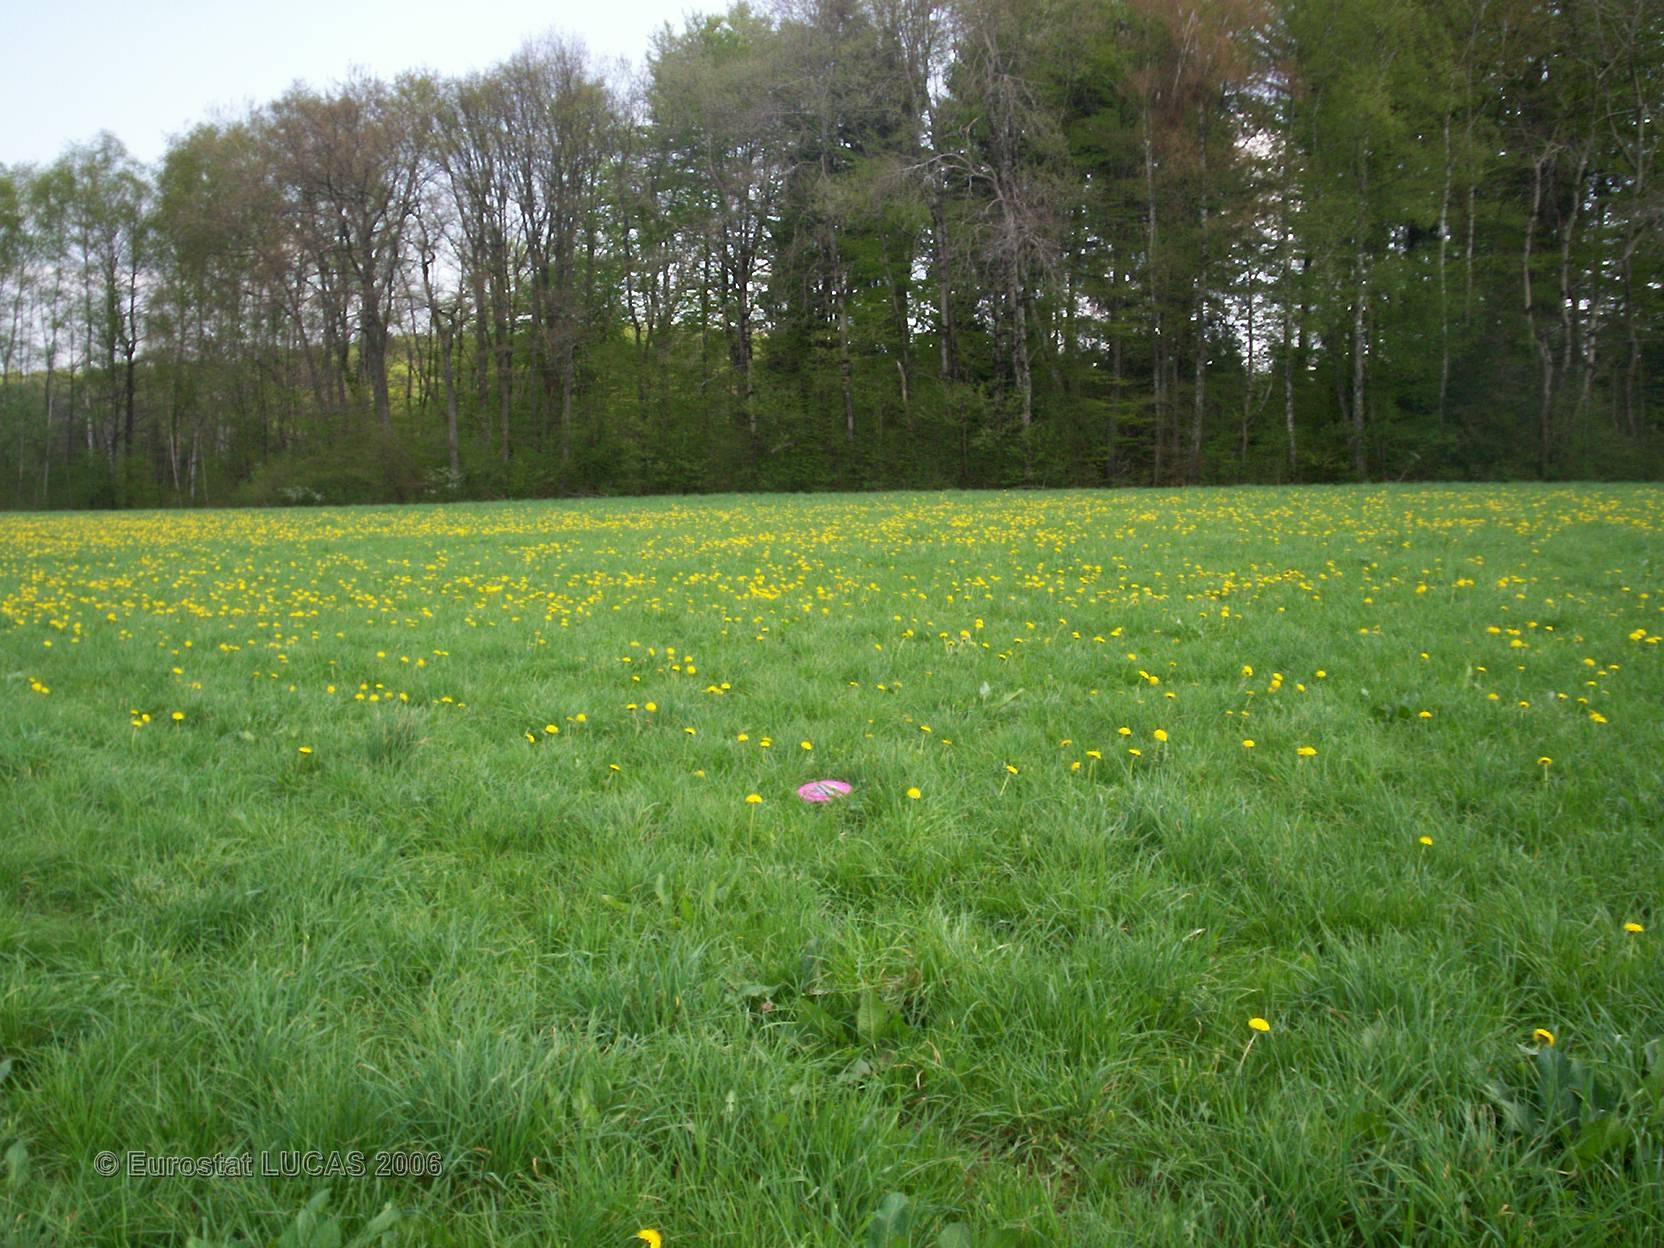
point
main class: Grassland
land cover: Grassland without tree/shrub cover
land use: Agriculture (excluding fallow land and kitchen gardens)
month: May
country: FR
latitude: 47.2090
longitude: 6.3712
